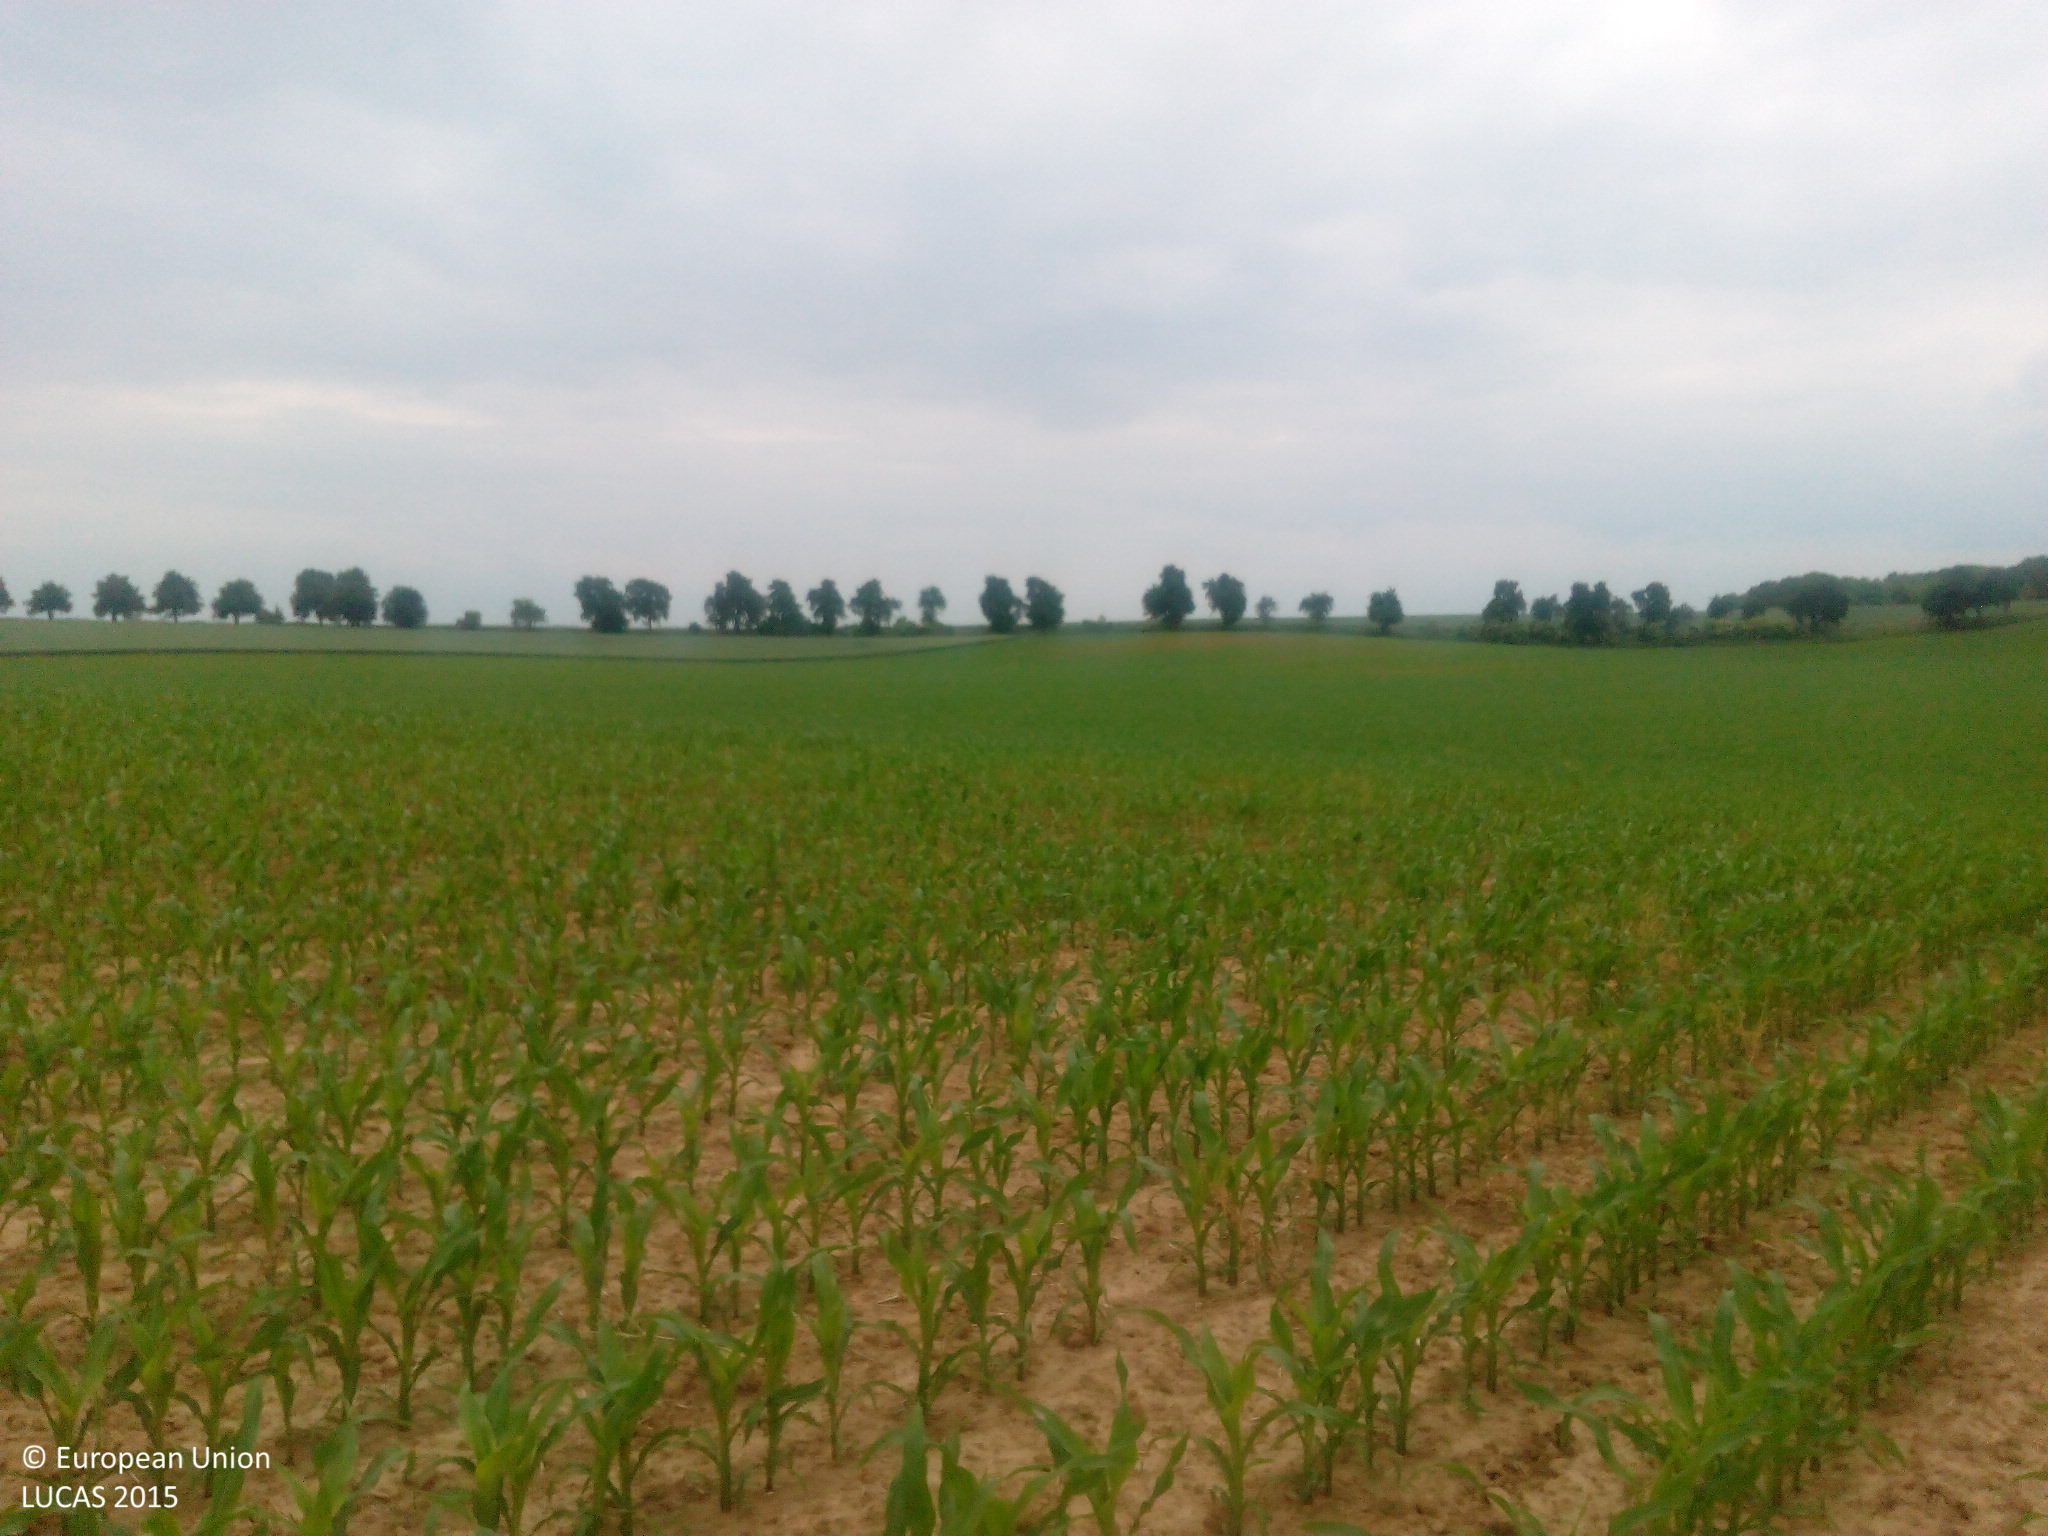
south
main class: Cropland
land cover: Maize
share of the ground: 25 - 50 %
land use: Agriculture (excluding fallow land and kitchen gardens)
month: June
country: DE
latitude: 51.2036
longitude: 13.1059
